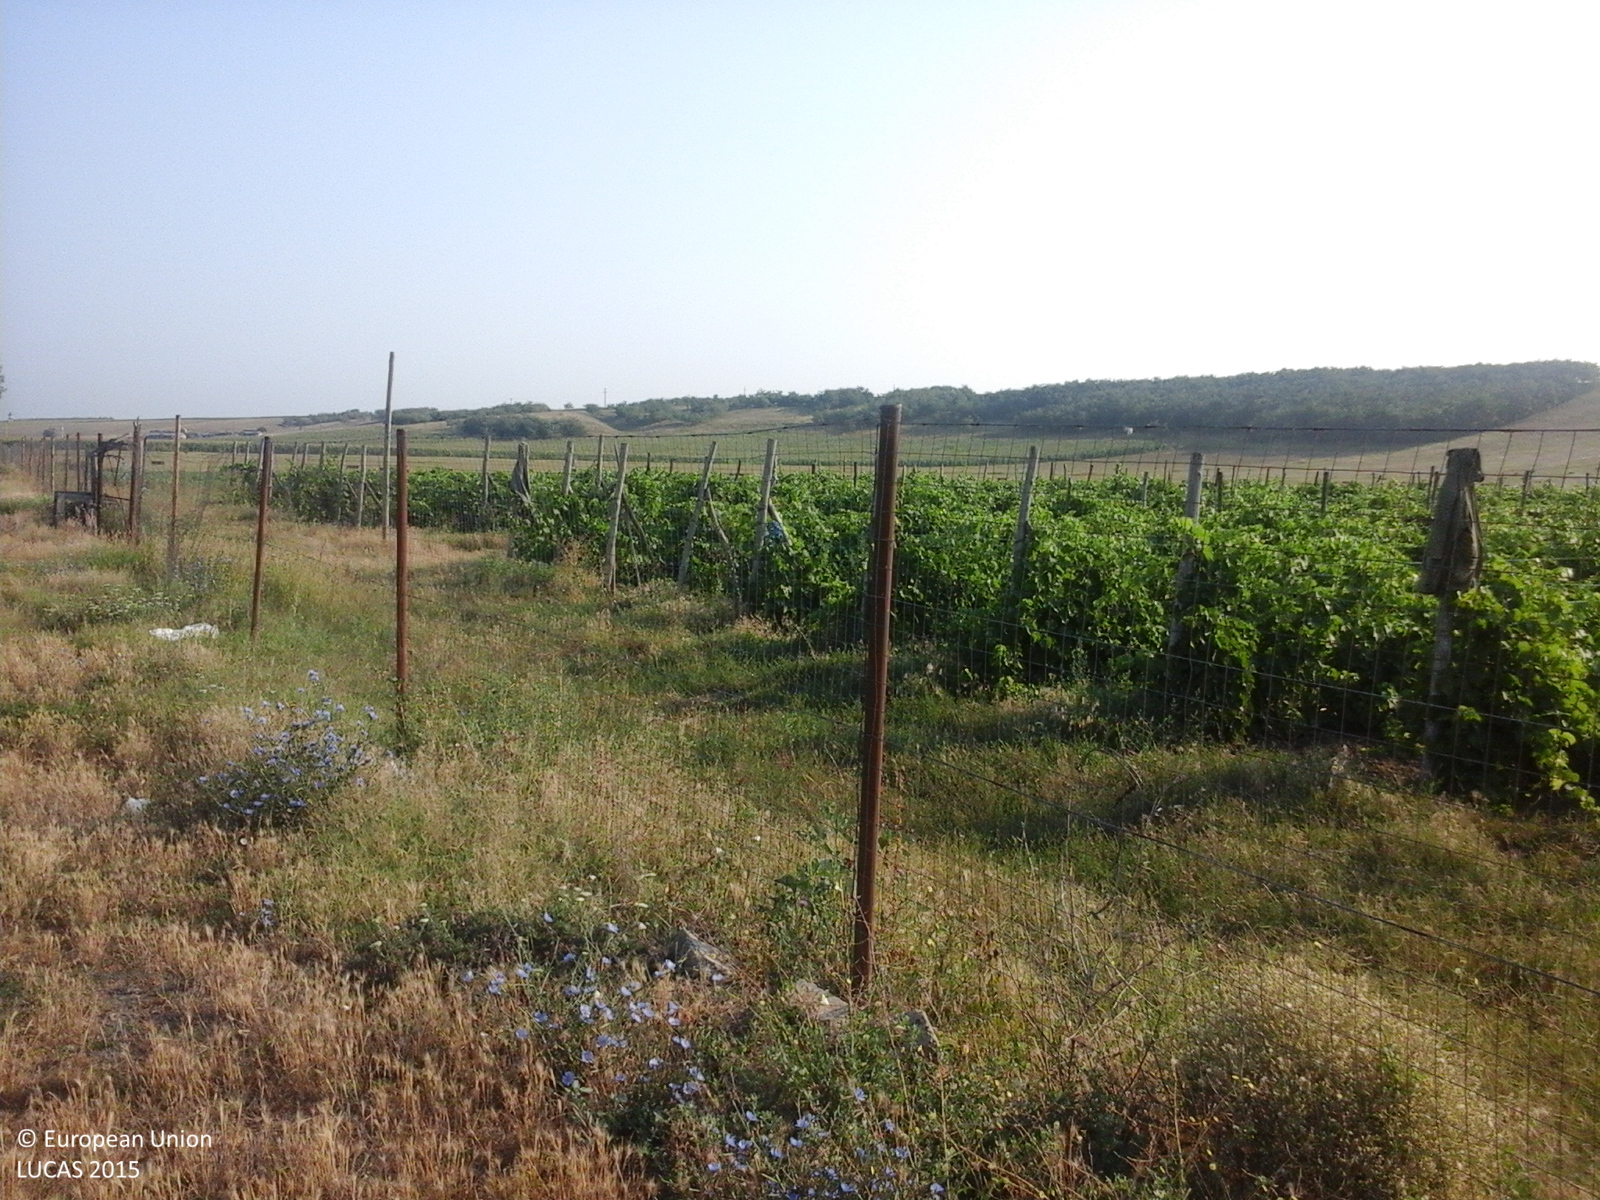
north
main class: Cropland
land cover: Vineyards
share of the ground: 50 - 75 %
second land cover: Grassland without tree/shrub cover
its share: > 75 %
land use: Agriculture (excluding fallow land and kitchen gardens)
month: July
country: RO
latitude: 45.7256
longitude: 27.7008
